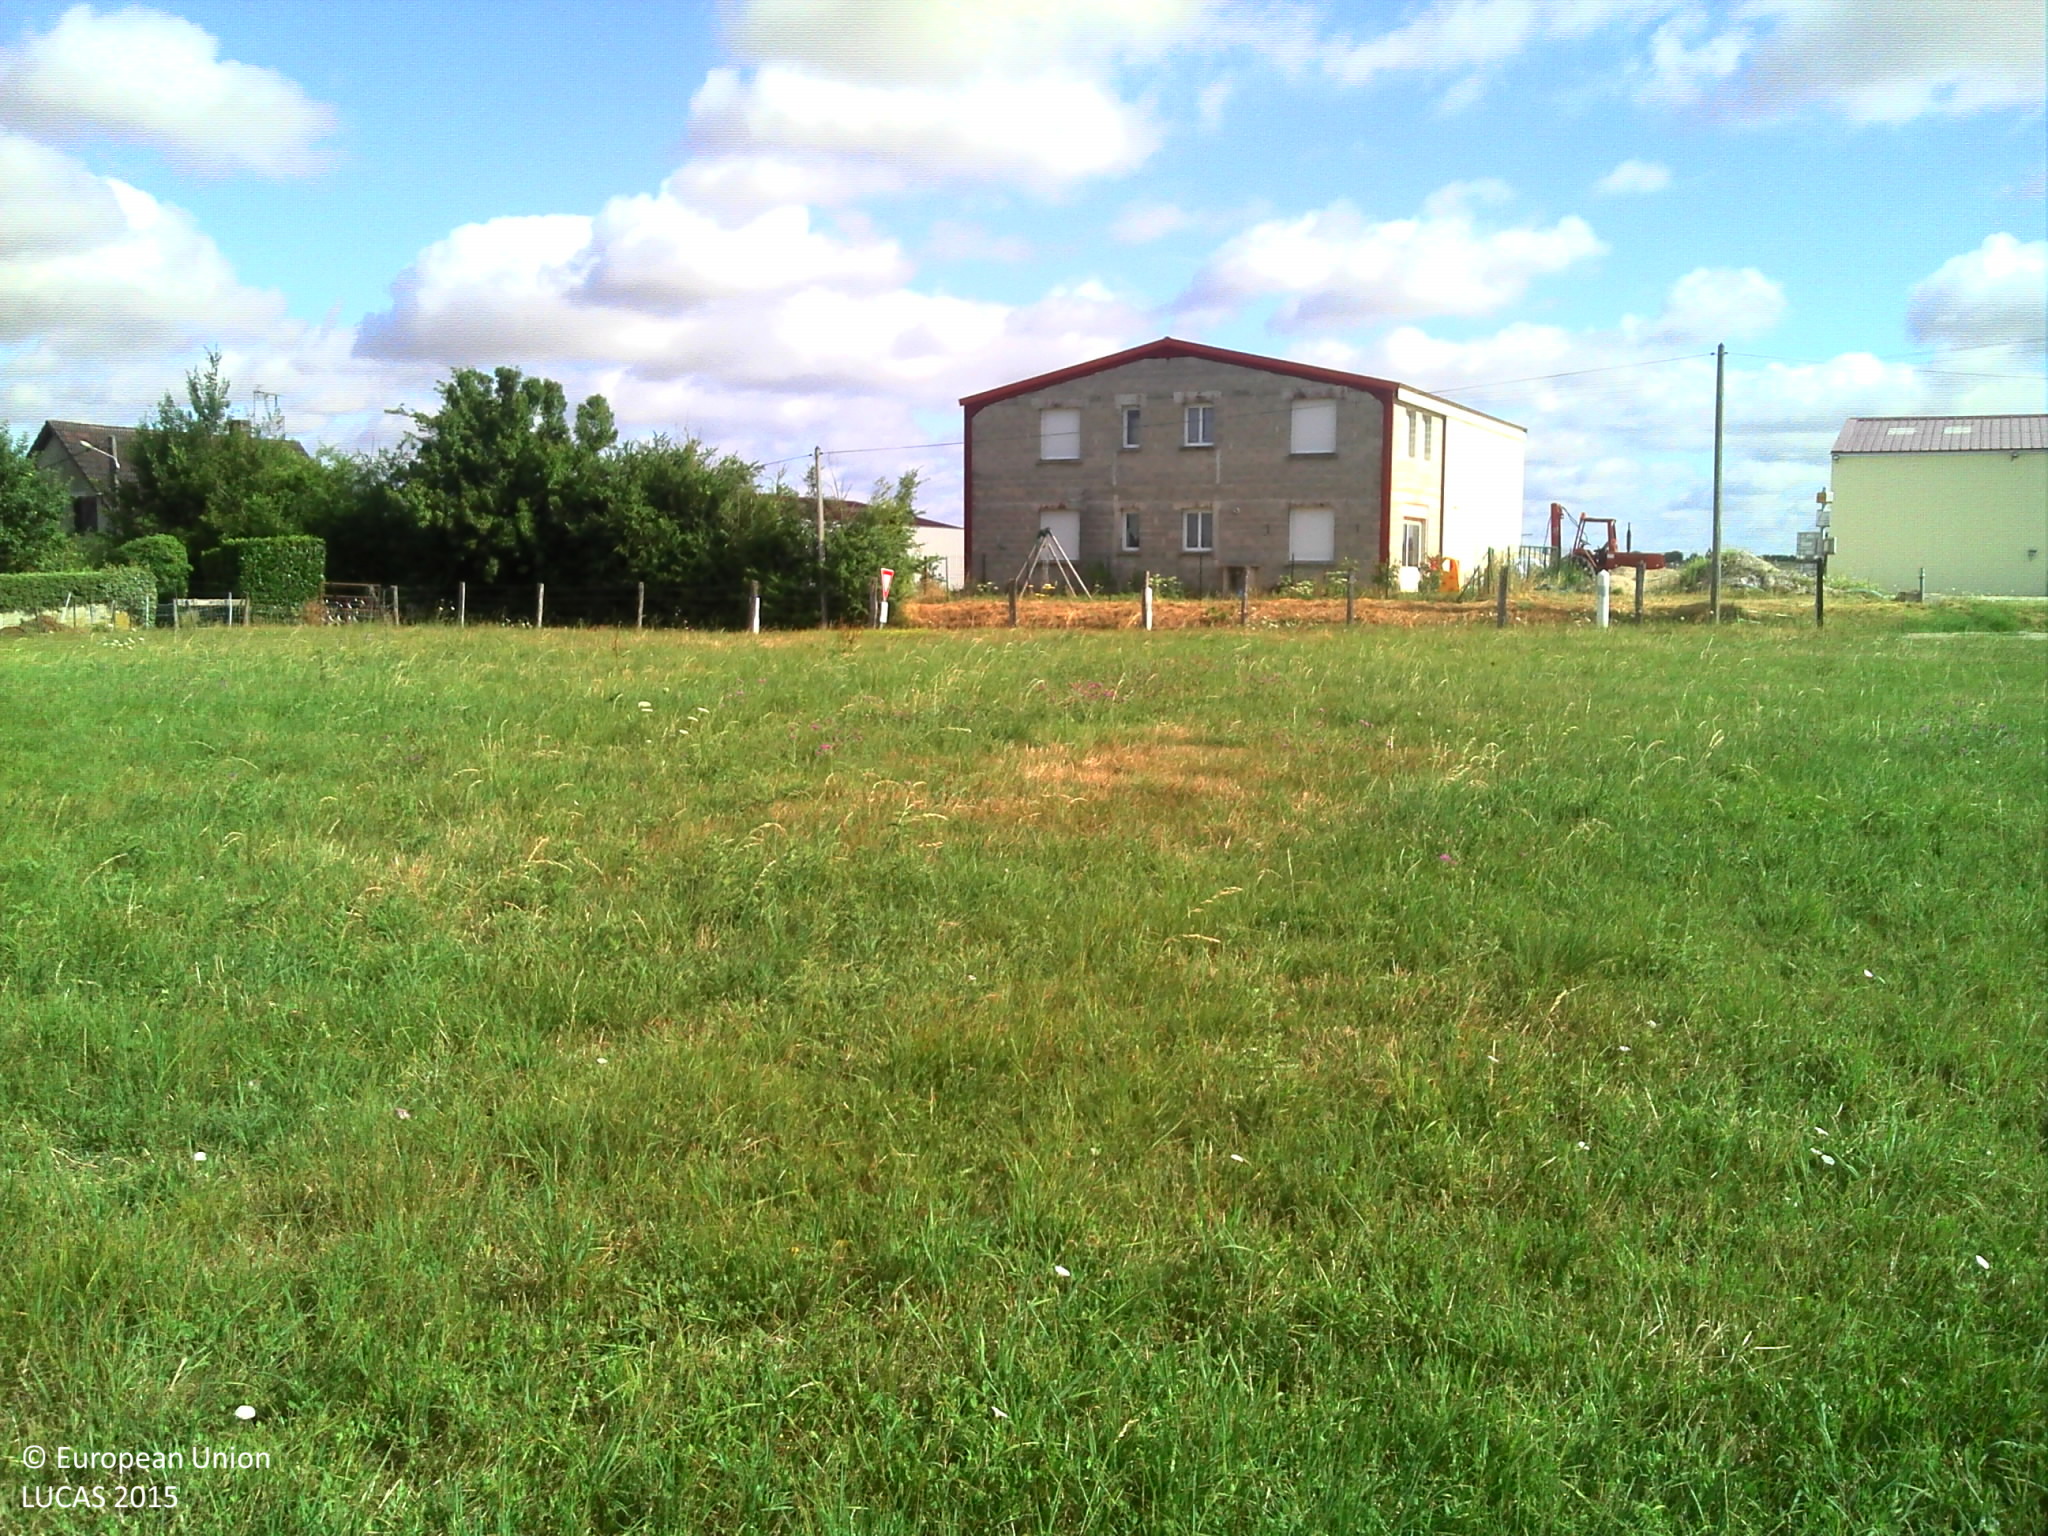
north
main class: Grassland
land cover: Grassland without tree/shrub cover
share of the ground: > 75 %
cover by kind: herbaceous plants 100 %
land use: Agriculture (excluding fallow land and kitchen gardens)
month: July
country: FR
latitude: 48.8591
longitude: 3.7654
